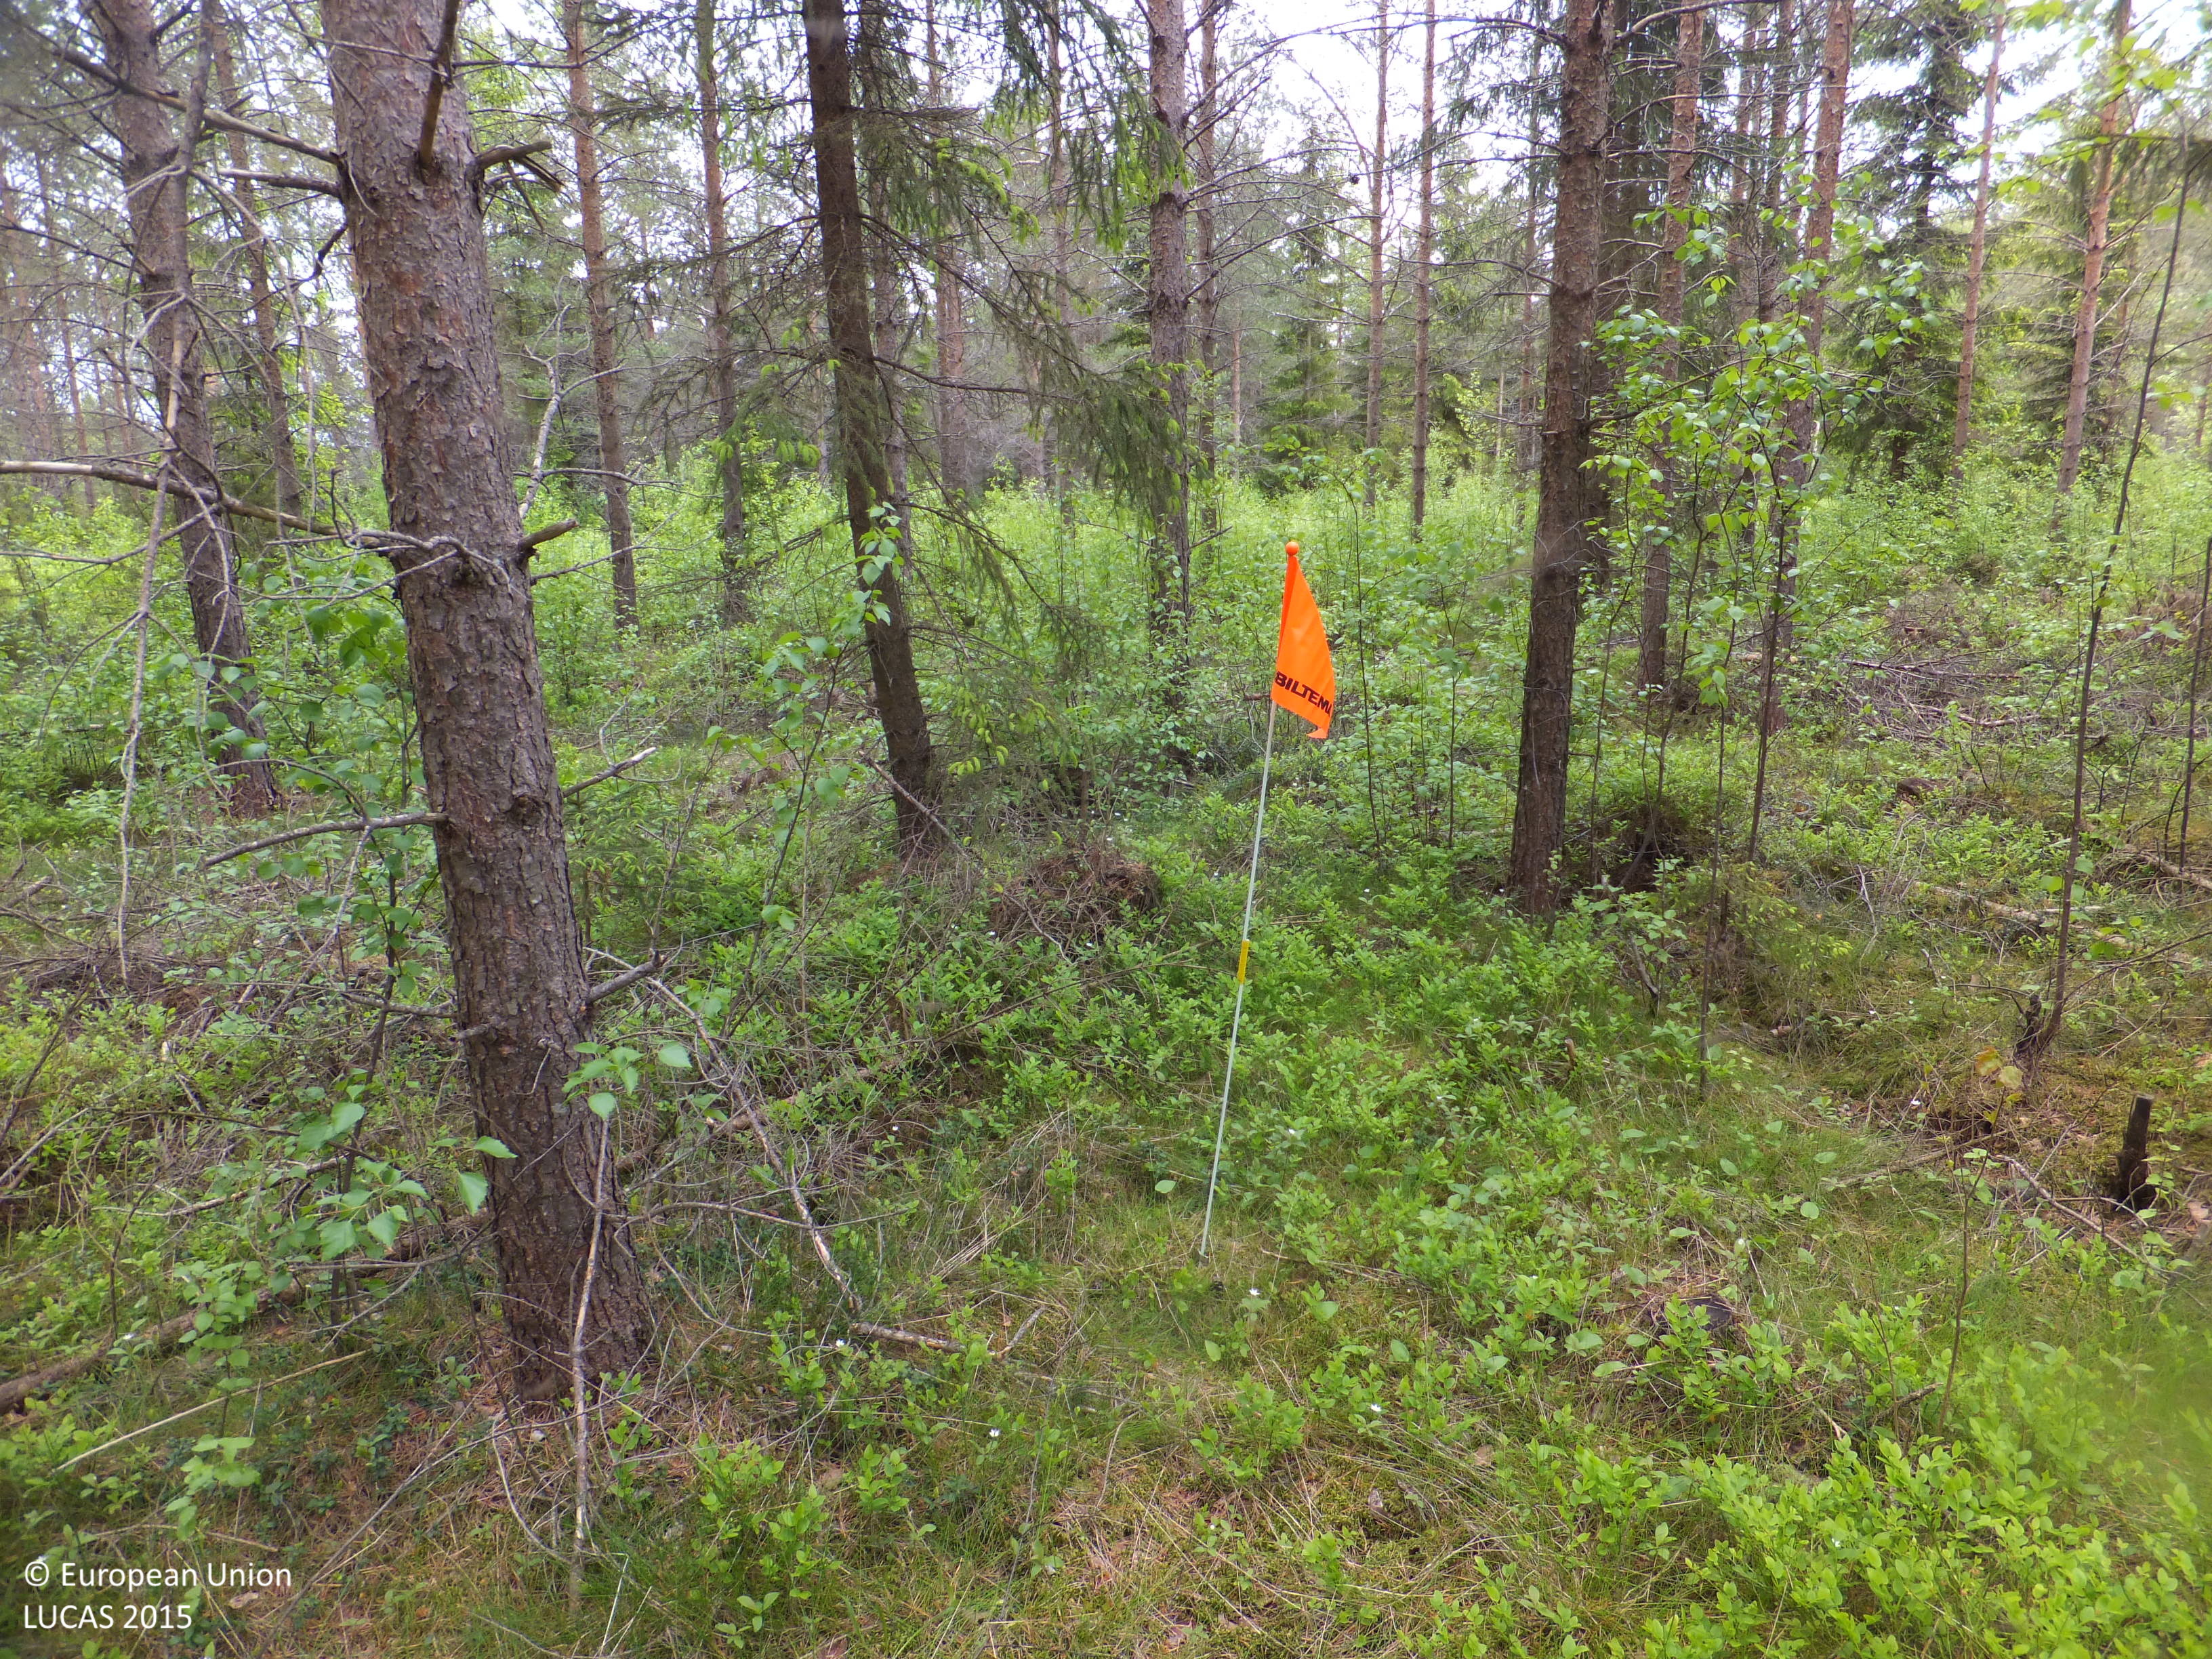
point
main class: Woodland
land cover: Pine dominated coniferous woodland
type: boreal forest
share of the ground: > 75 %
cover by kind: coniferous forest trees 80 %, broadleaved forest trees 5 %, shrubs 5 %, herbaceous plants 5 %, lichens and mosses 5 %
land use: Forestry
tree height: > 5 m
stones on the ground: 10 - 25 %
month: June
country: FI
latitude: 63.3329
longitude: 22.7337
